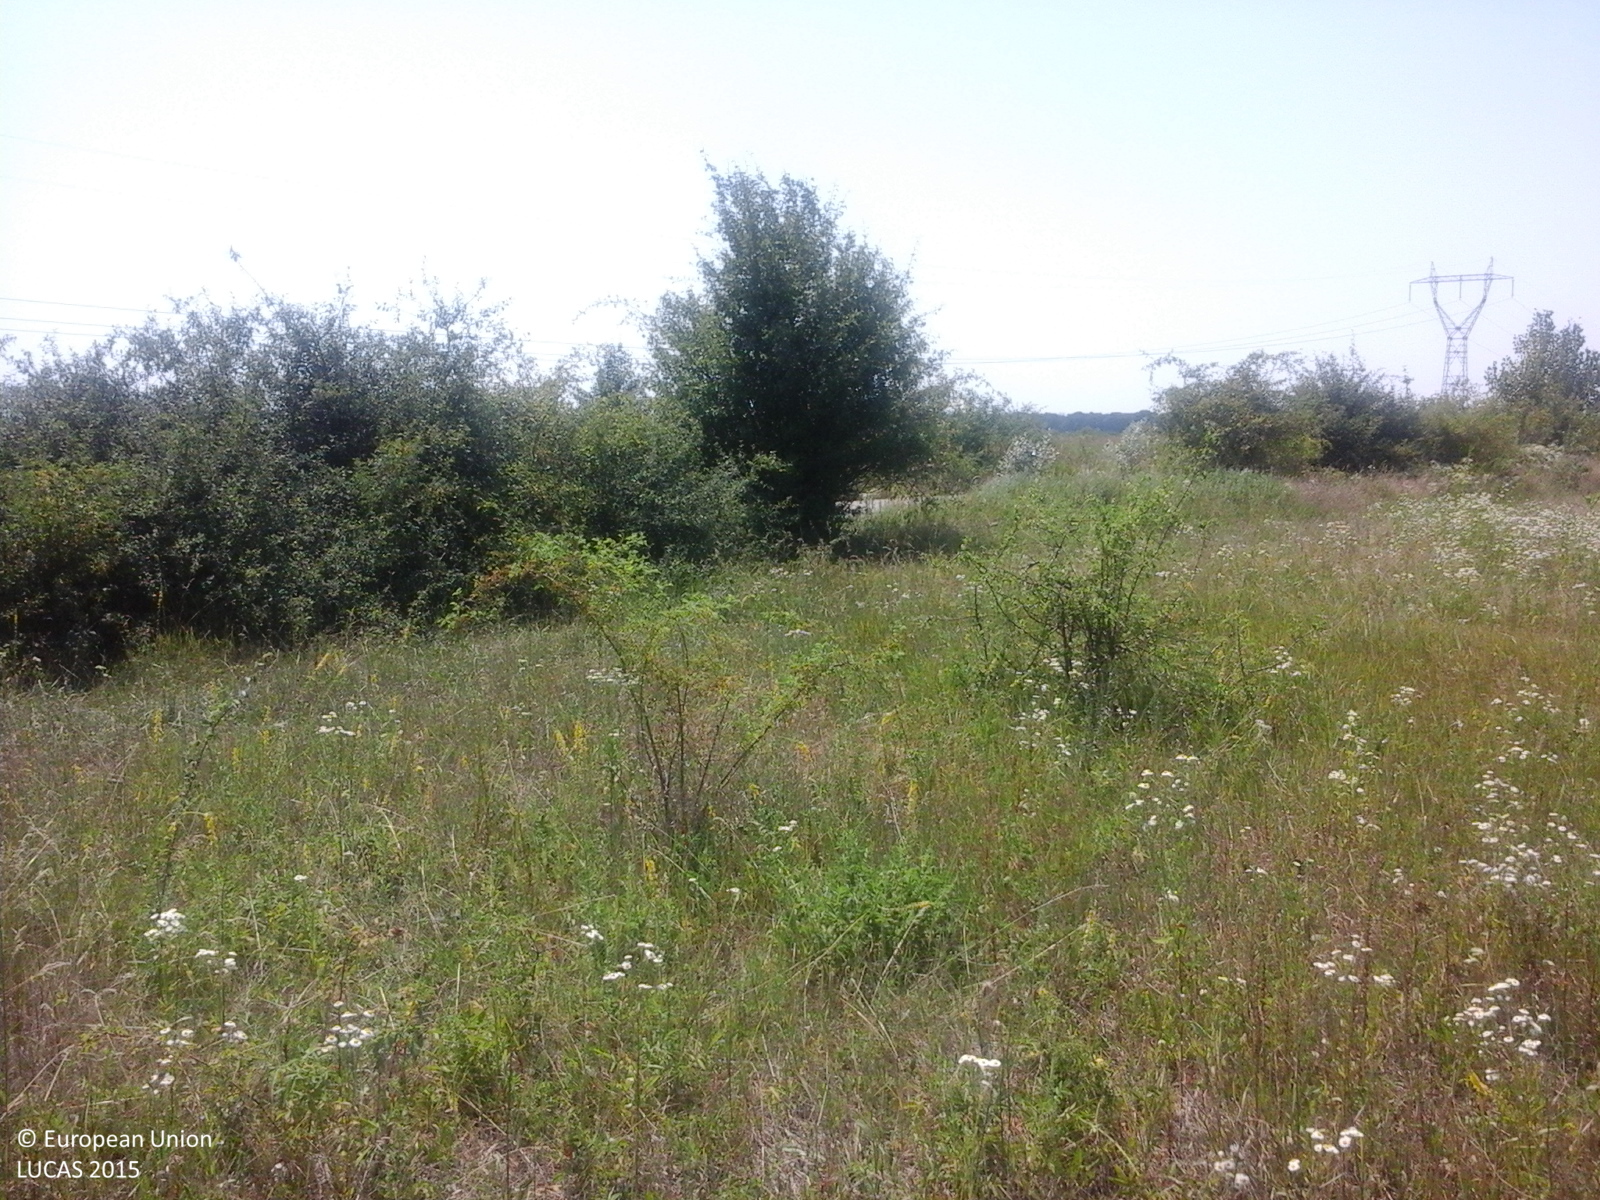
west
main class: Grassland
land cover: Grassland with sparse tree/shrub cover
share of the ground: > 75 %
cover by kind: herbaceous plants 95 %, broadleaved forest trees 5 %
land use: Agriculture (excluding fallow land and kitchen gardens)
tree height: < 5 m
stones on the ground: < 10 %
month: July
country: RO
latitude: 44.7657
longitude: 24.7985
